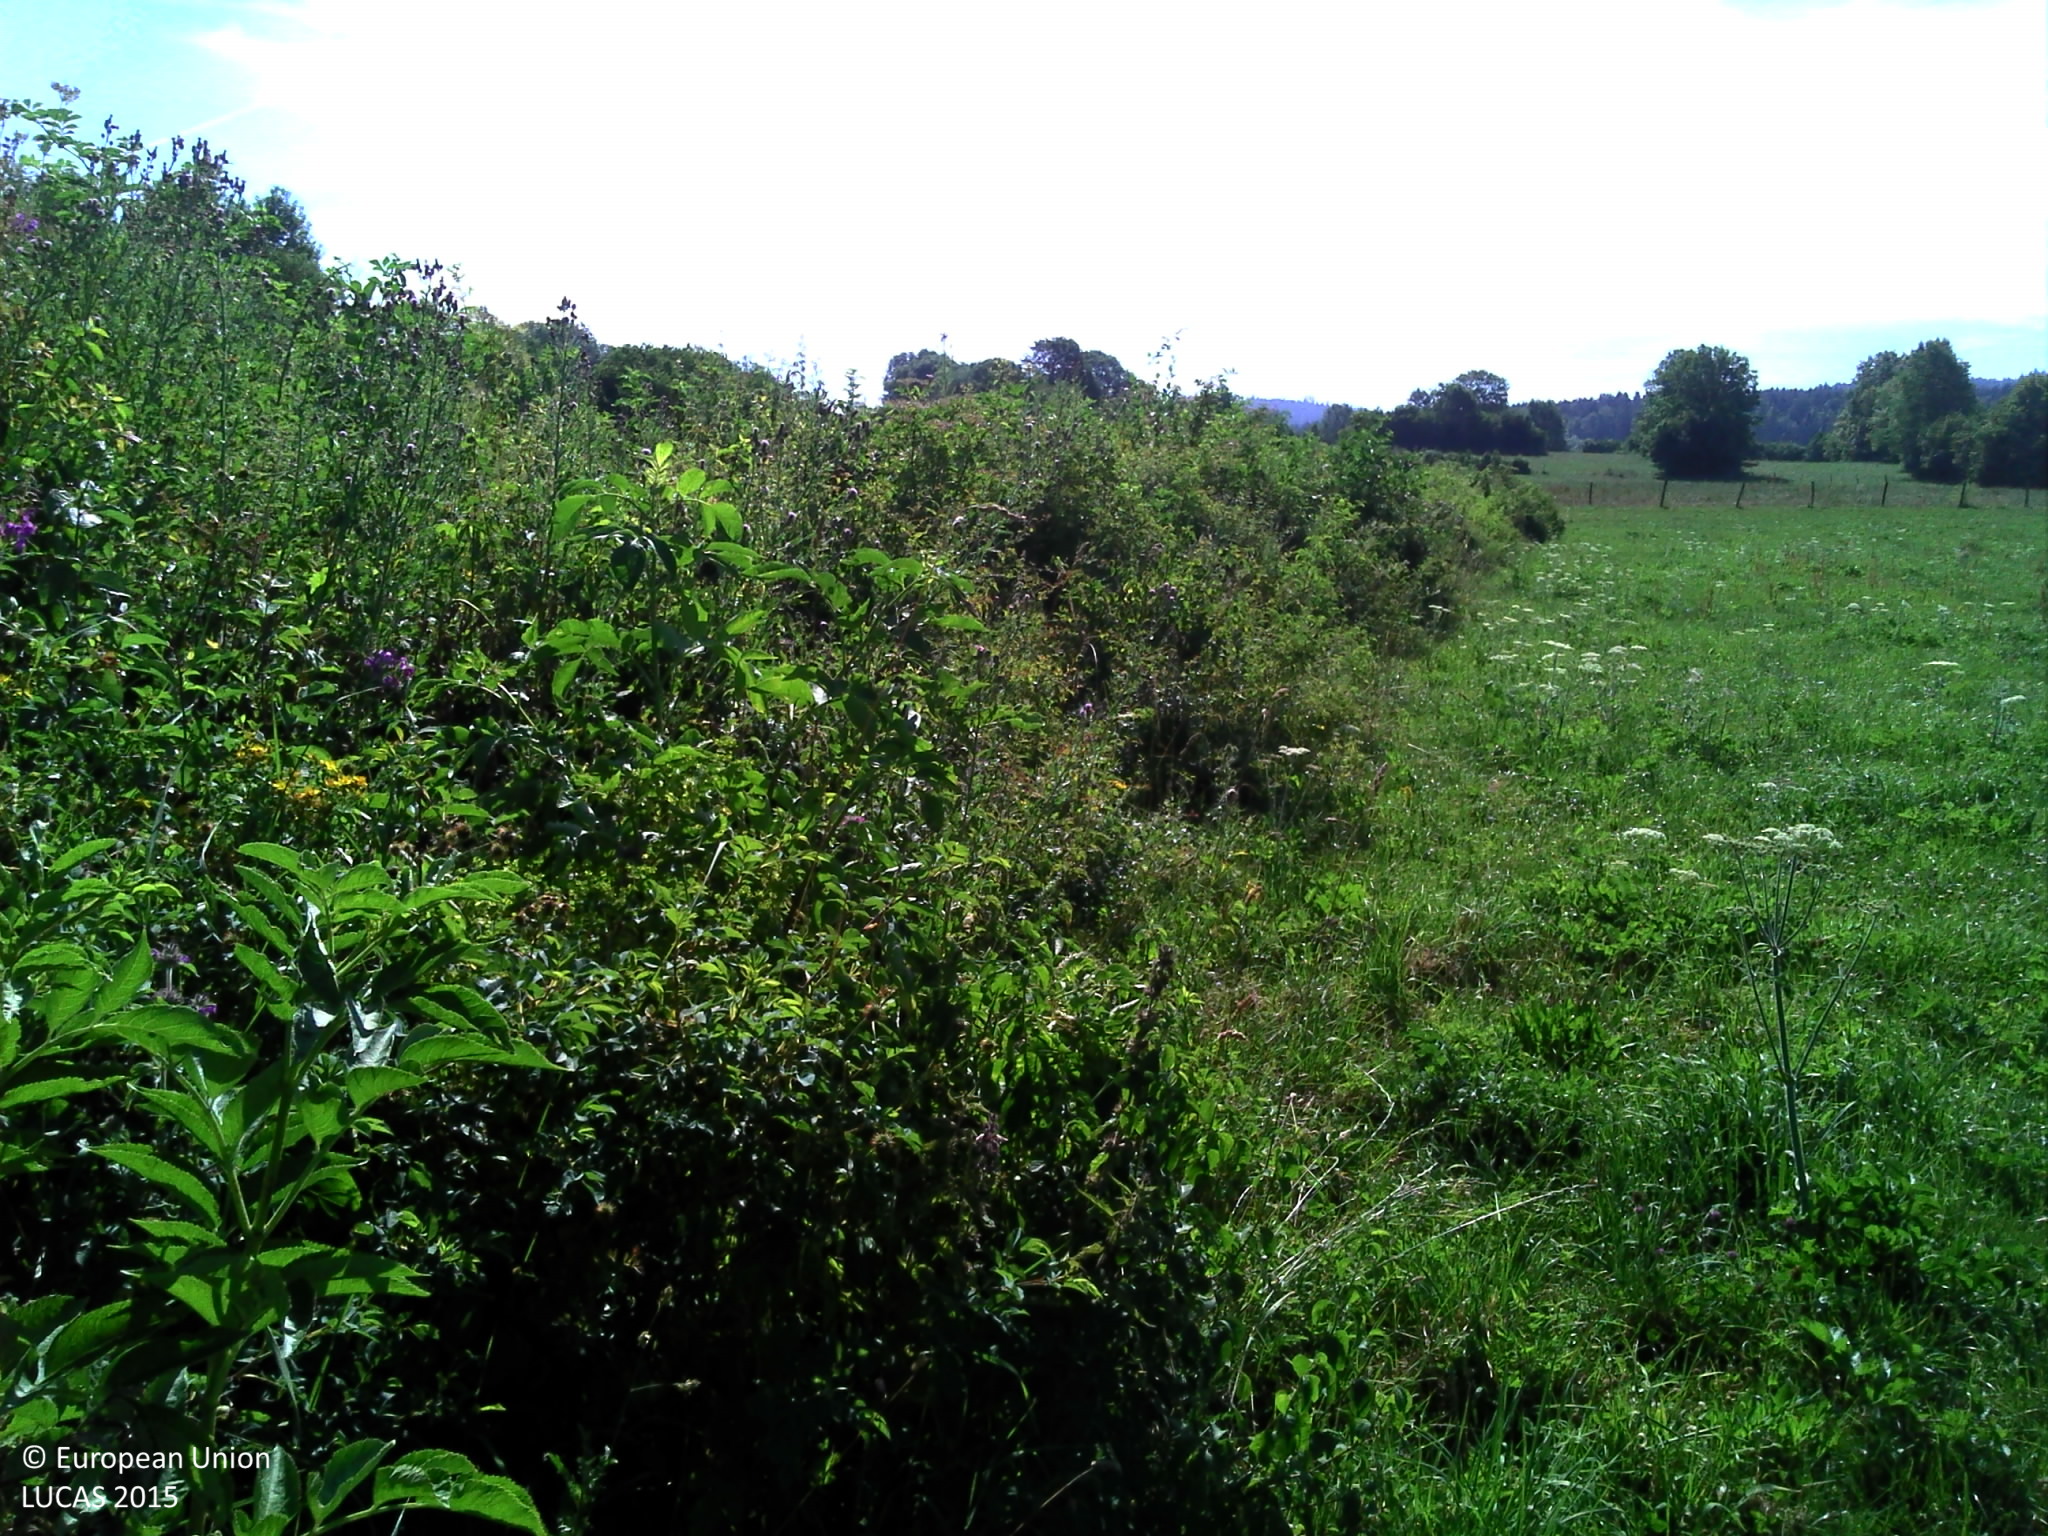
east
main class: Shrubland
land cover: Shrubland without tree cover
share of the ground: > 75 %
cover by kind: shrubs 100 %
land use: Agriculture (excluding fallow land and kitchen gardens)
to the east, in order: Shrubland without tree cover; Grassland without tree/shrub cover; Fences; Grass margins; Tracks; Grassland without tree/shrub cover; Shrubland without tree cover
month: July
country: FR
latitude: 46.7863
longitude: 6.1383
